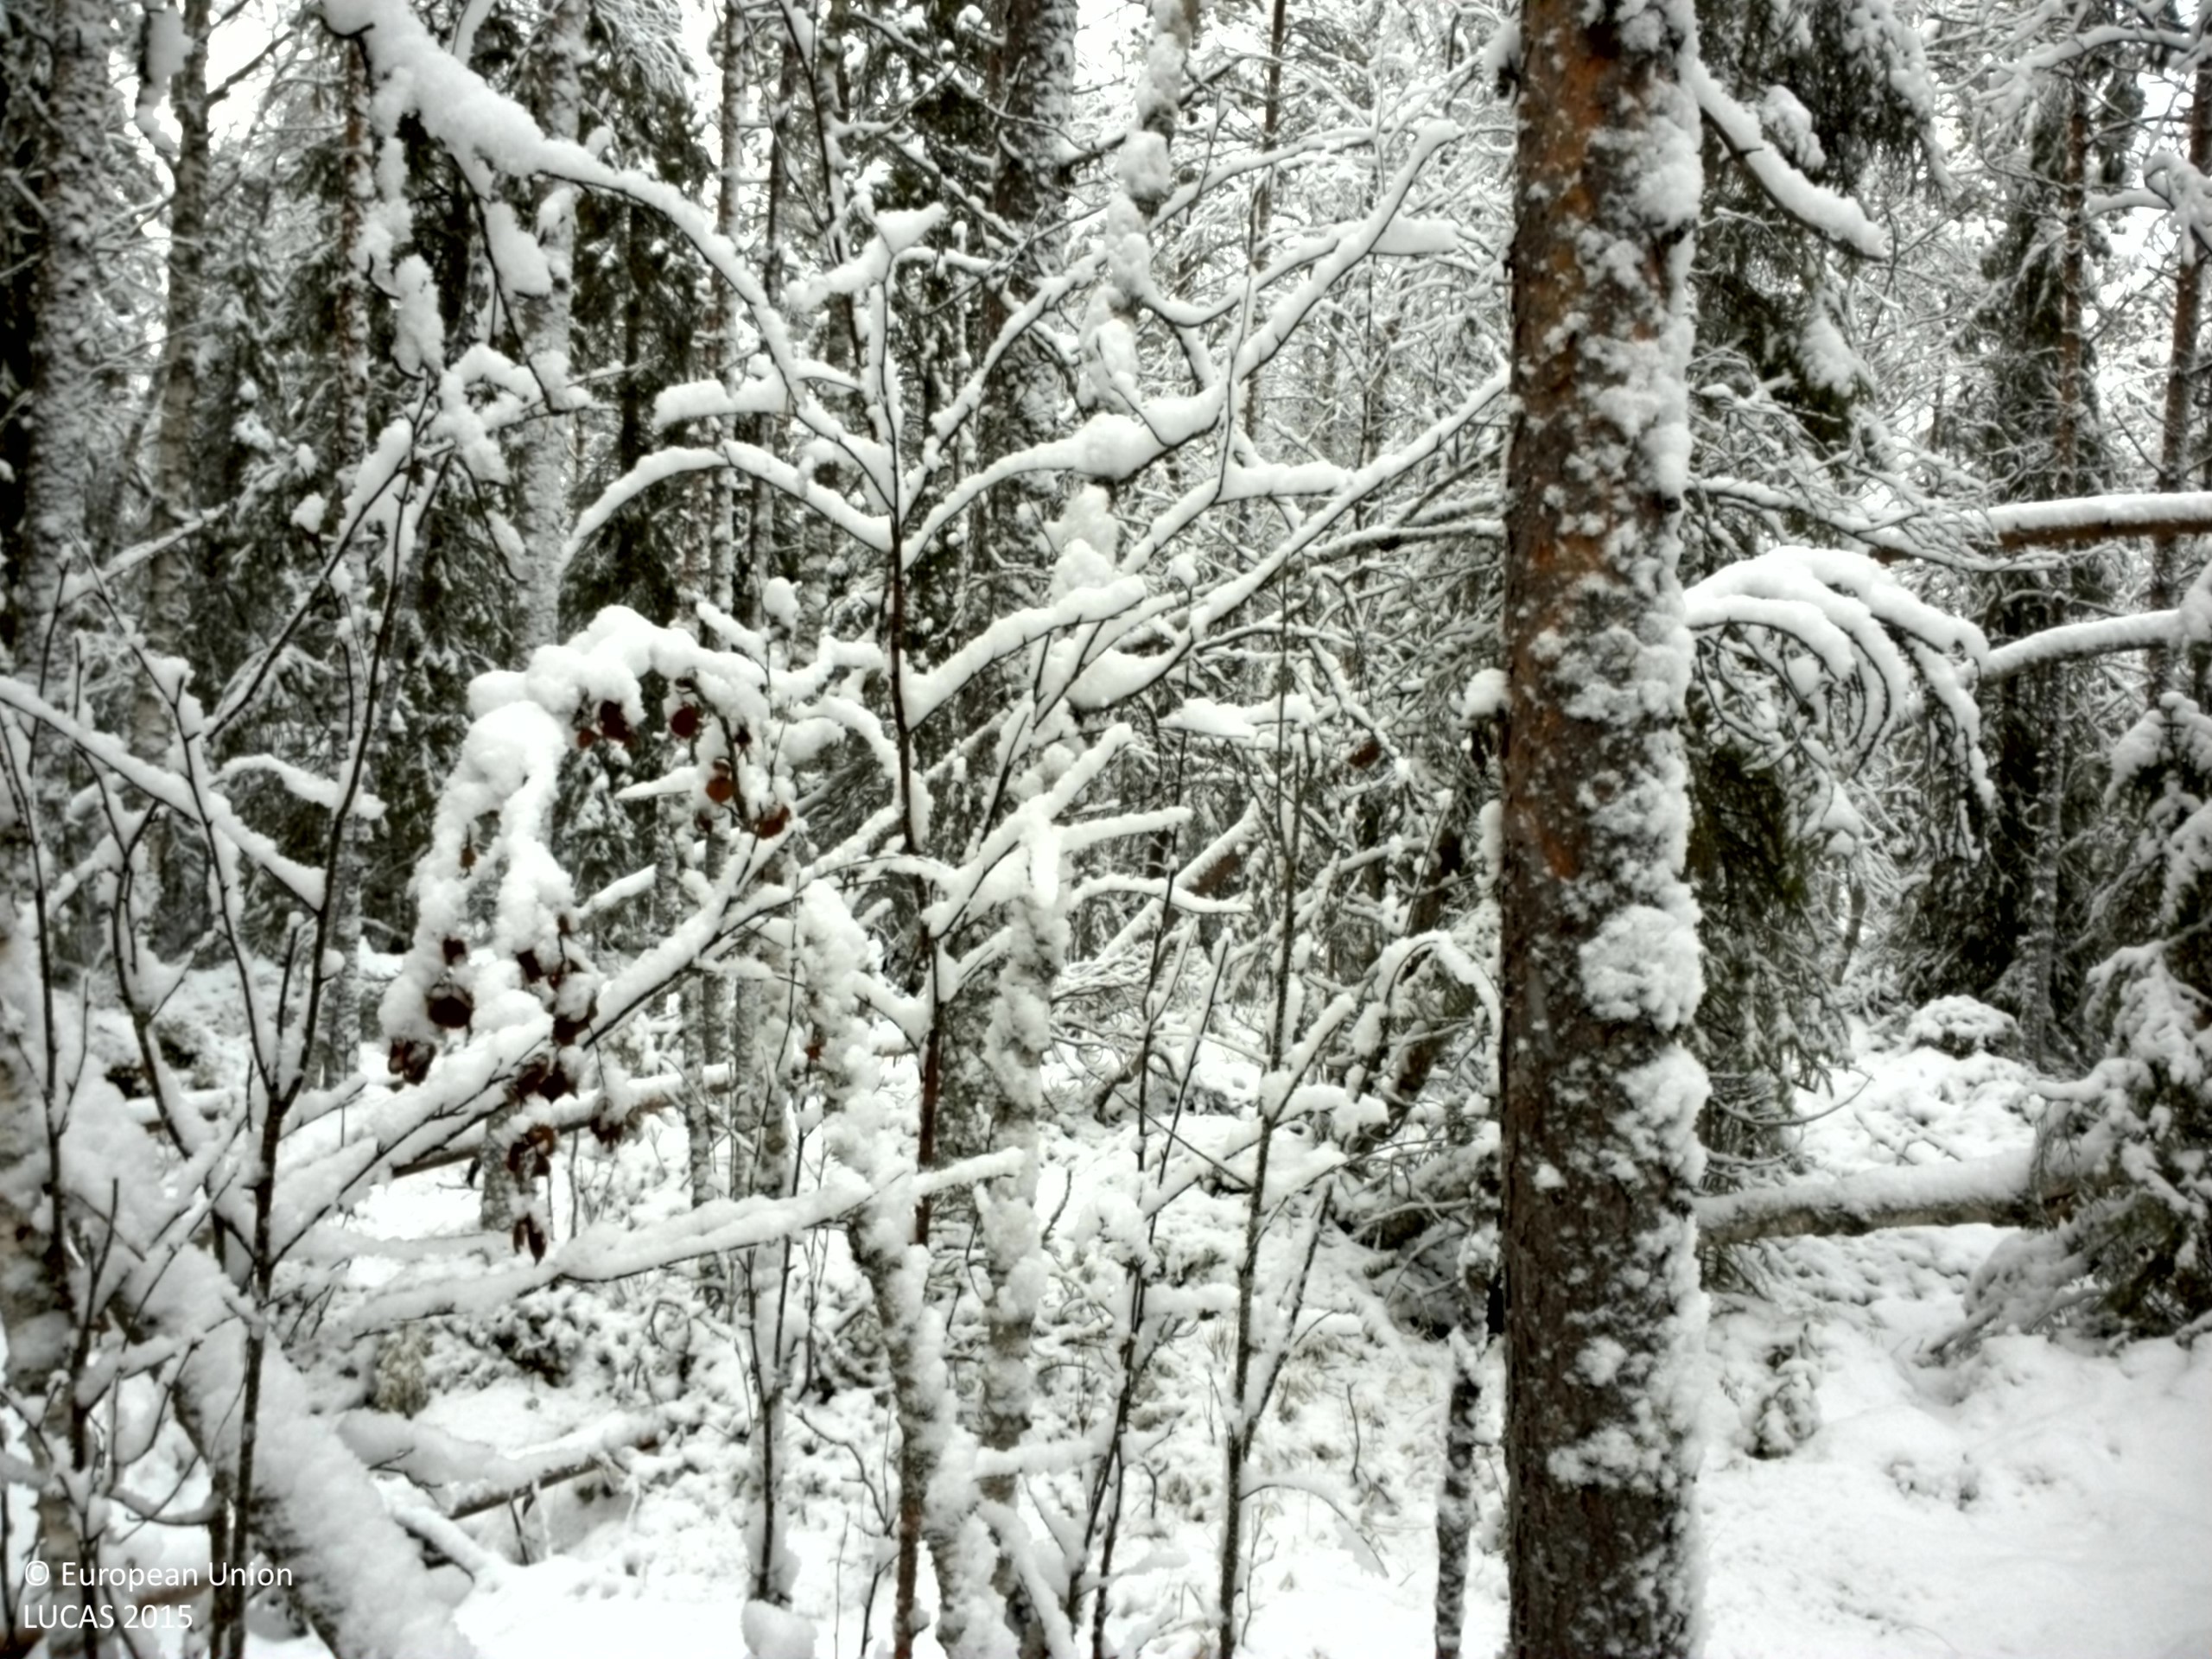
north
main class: Woodland
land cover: Other mixed woodland
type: boreal forest
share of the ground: 50 - 75 %
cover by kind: coniferous forest trees 45 %, shrubs 25 %, broadleaved forest trees 15 %, lichens and mosses 10 %, herbaceous plants 5 %
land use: Forestry
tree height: > 5 m
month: November
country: SE
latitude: 63.7595
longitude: 15.5081
